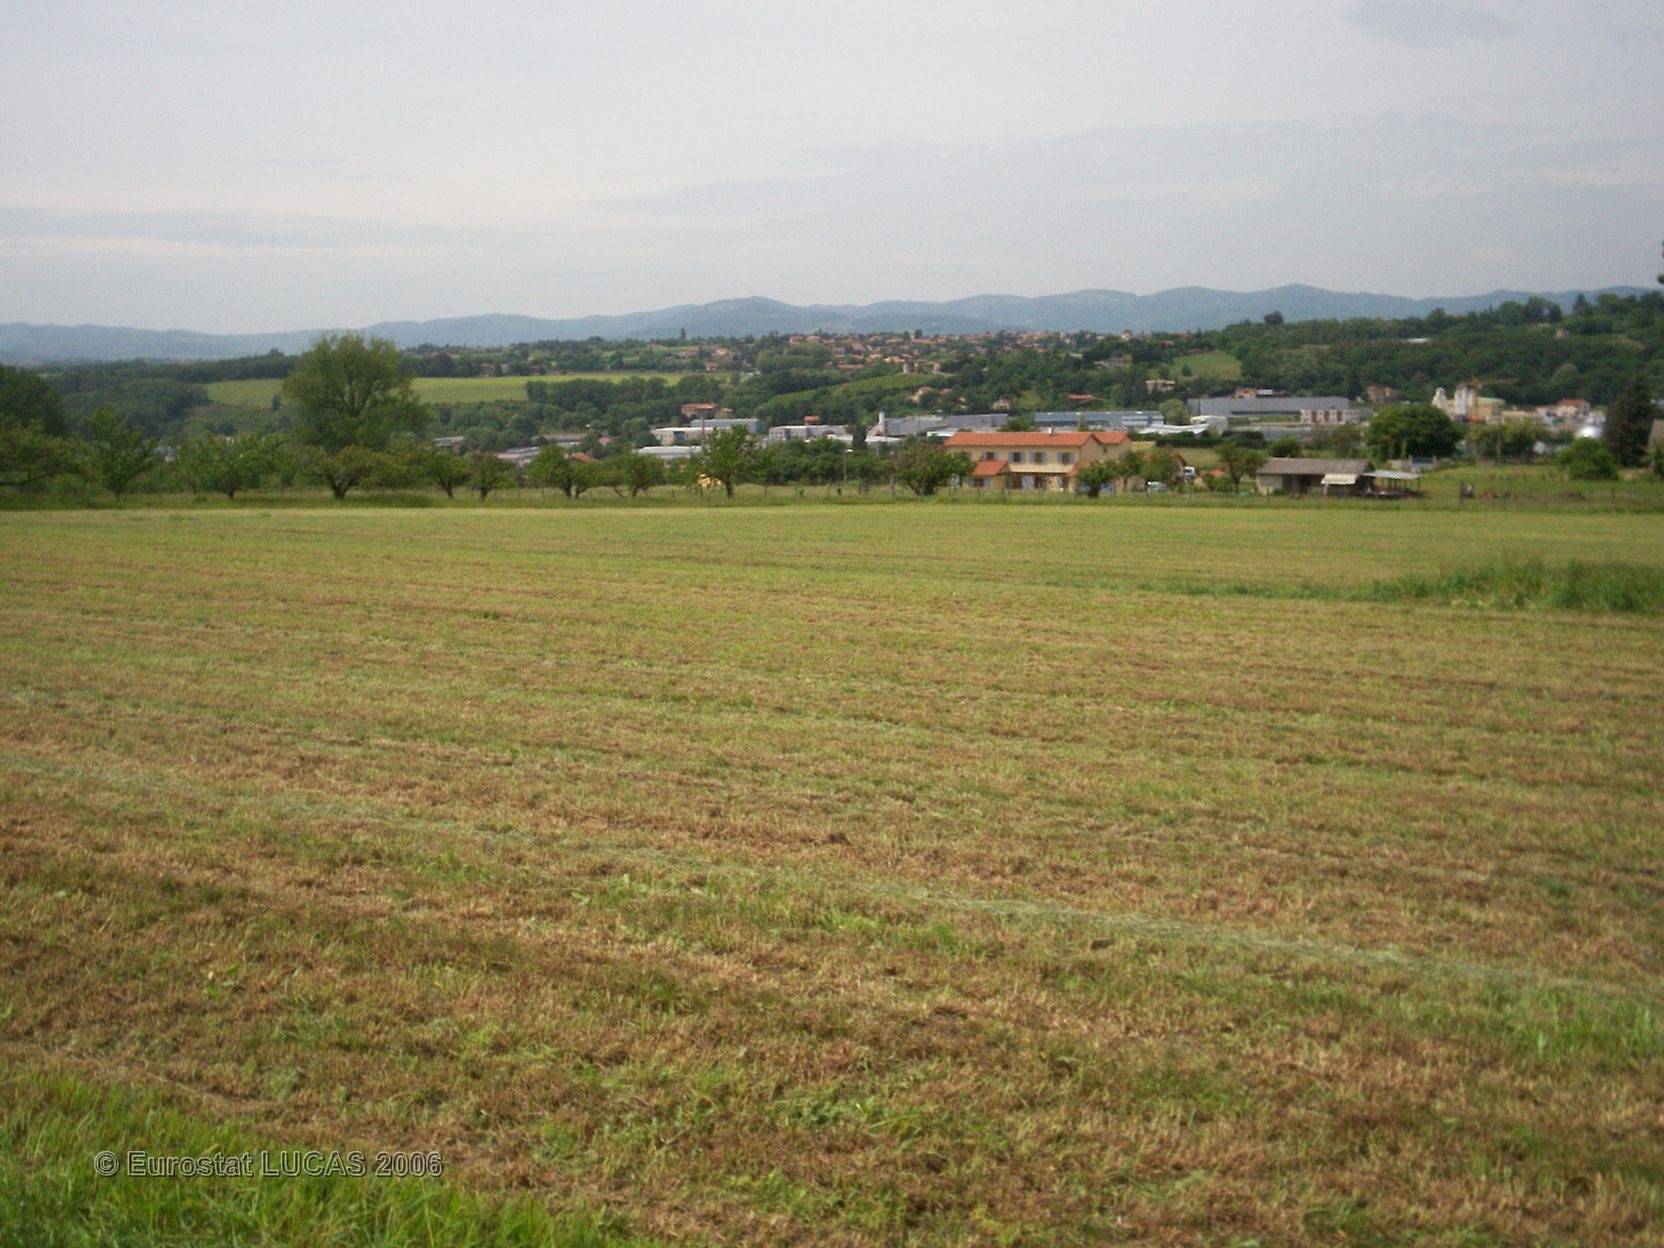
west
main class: Grassland
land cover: Grassland without tree/shrub cover
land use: Agriculture (excluding fallow land and kitchen gardens)
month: May
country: FR
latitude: 45.7001
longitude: 4.7764
